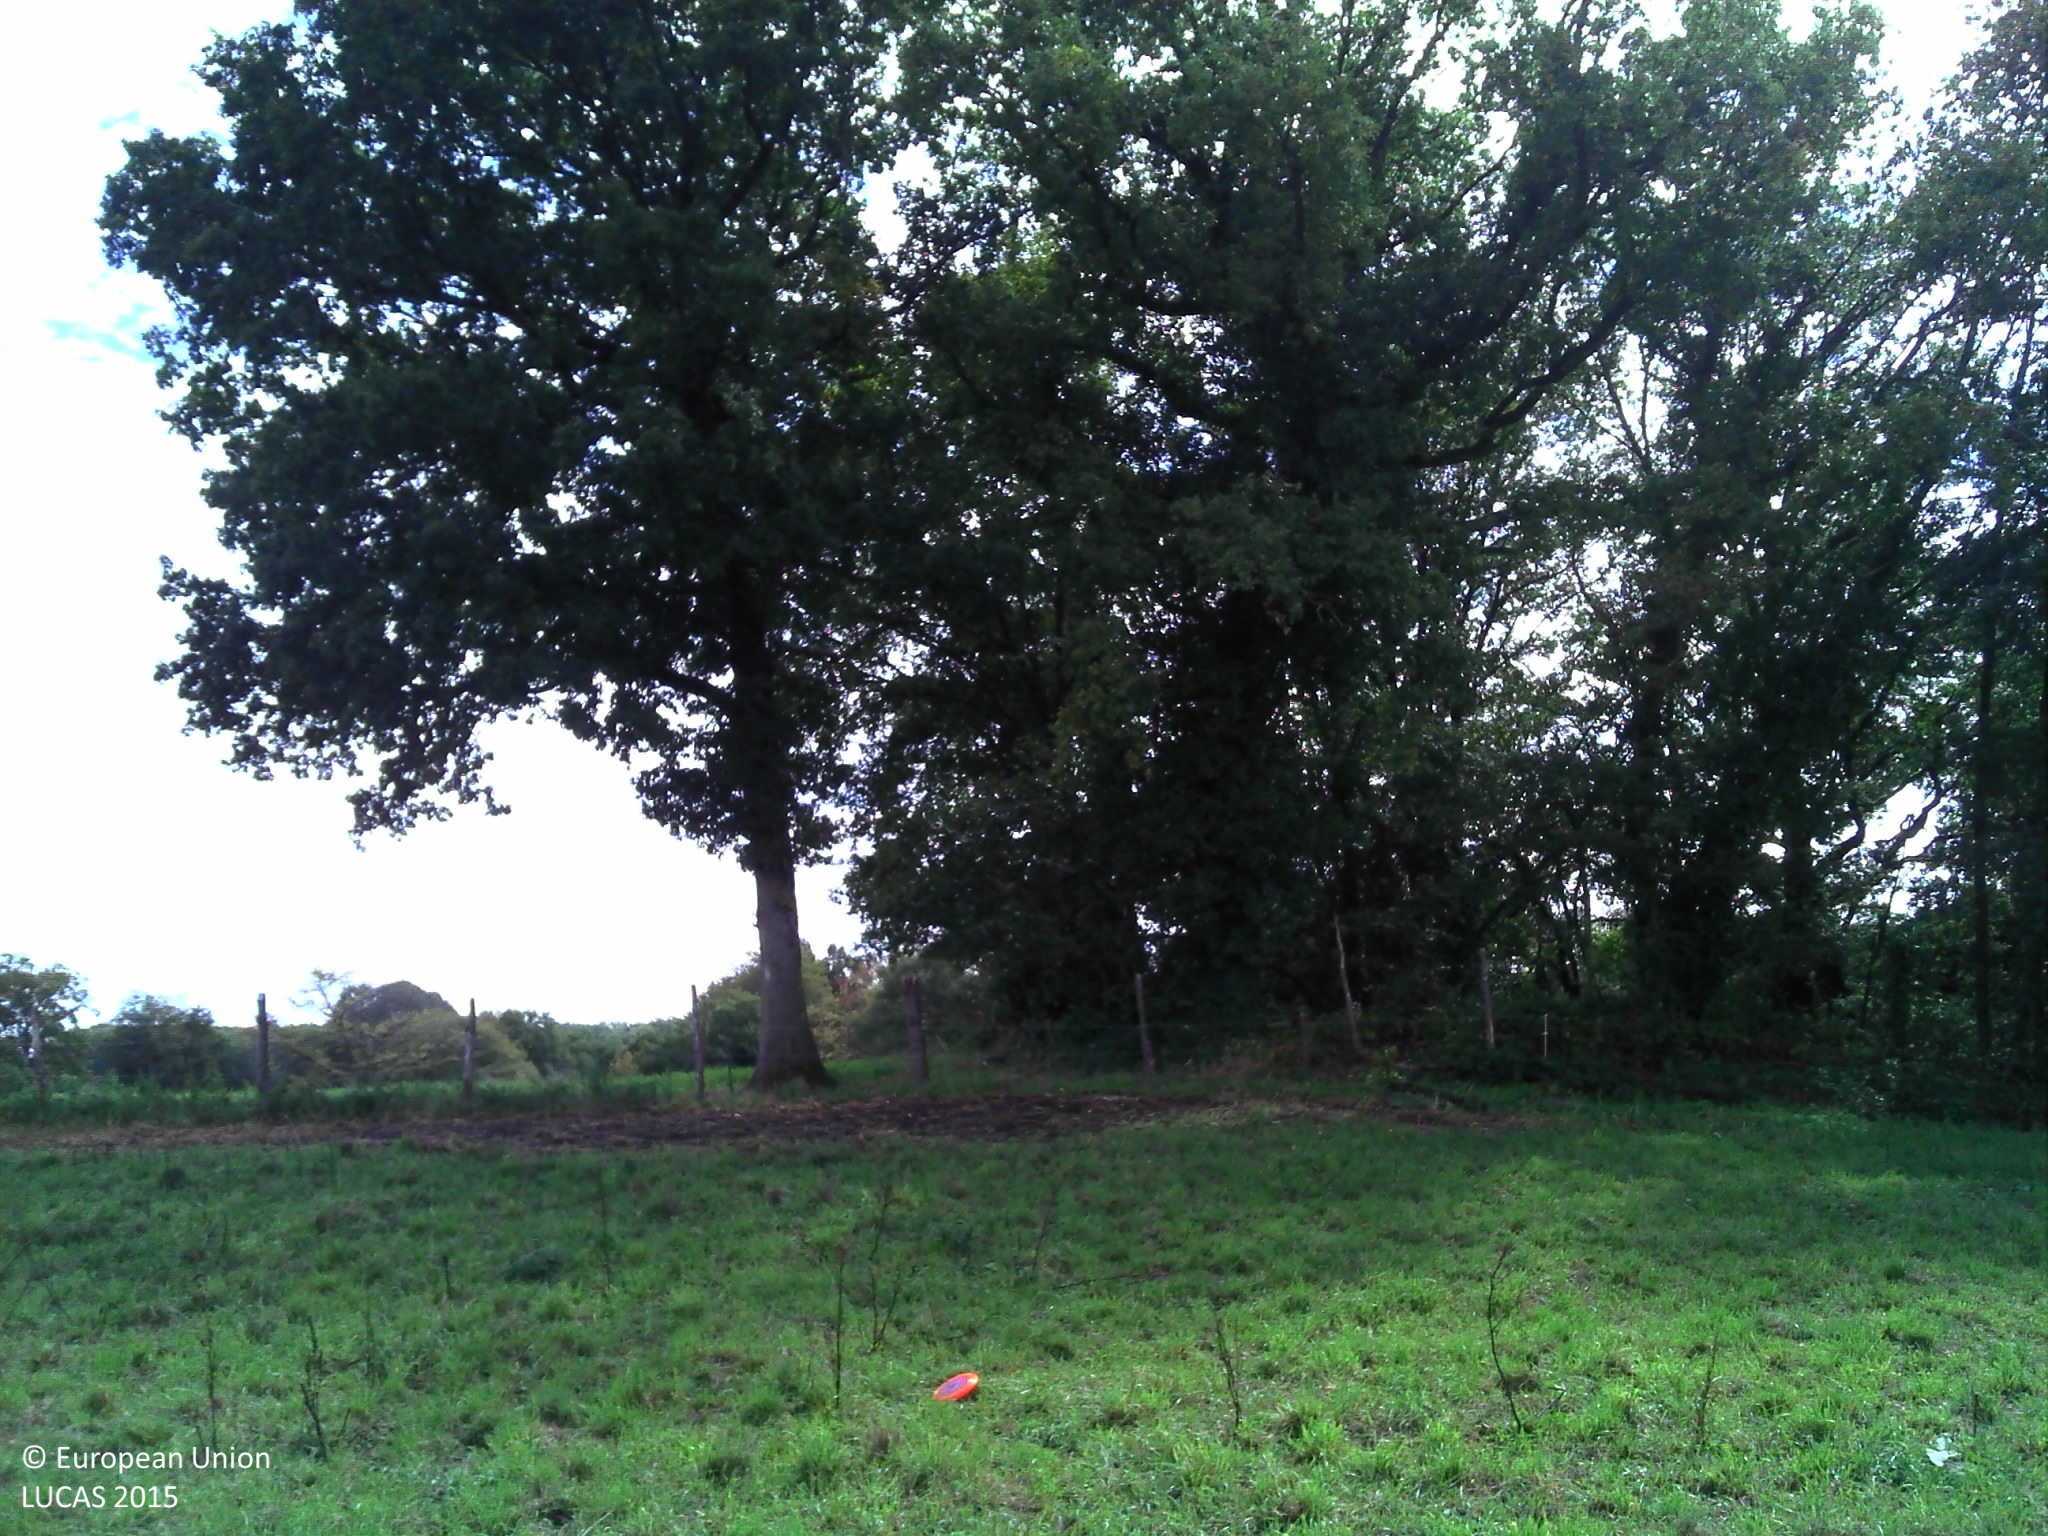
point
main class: Grassland
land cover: Grassland without tree/shrub cover
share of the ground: > 75 %
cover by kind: herbaceous plants 100 %
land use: Agriculture (excluding fallow land and kitchen gardens)
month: September
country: FR
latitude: 46.4445
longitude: 1.6993
